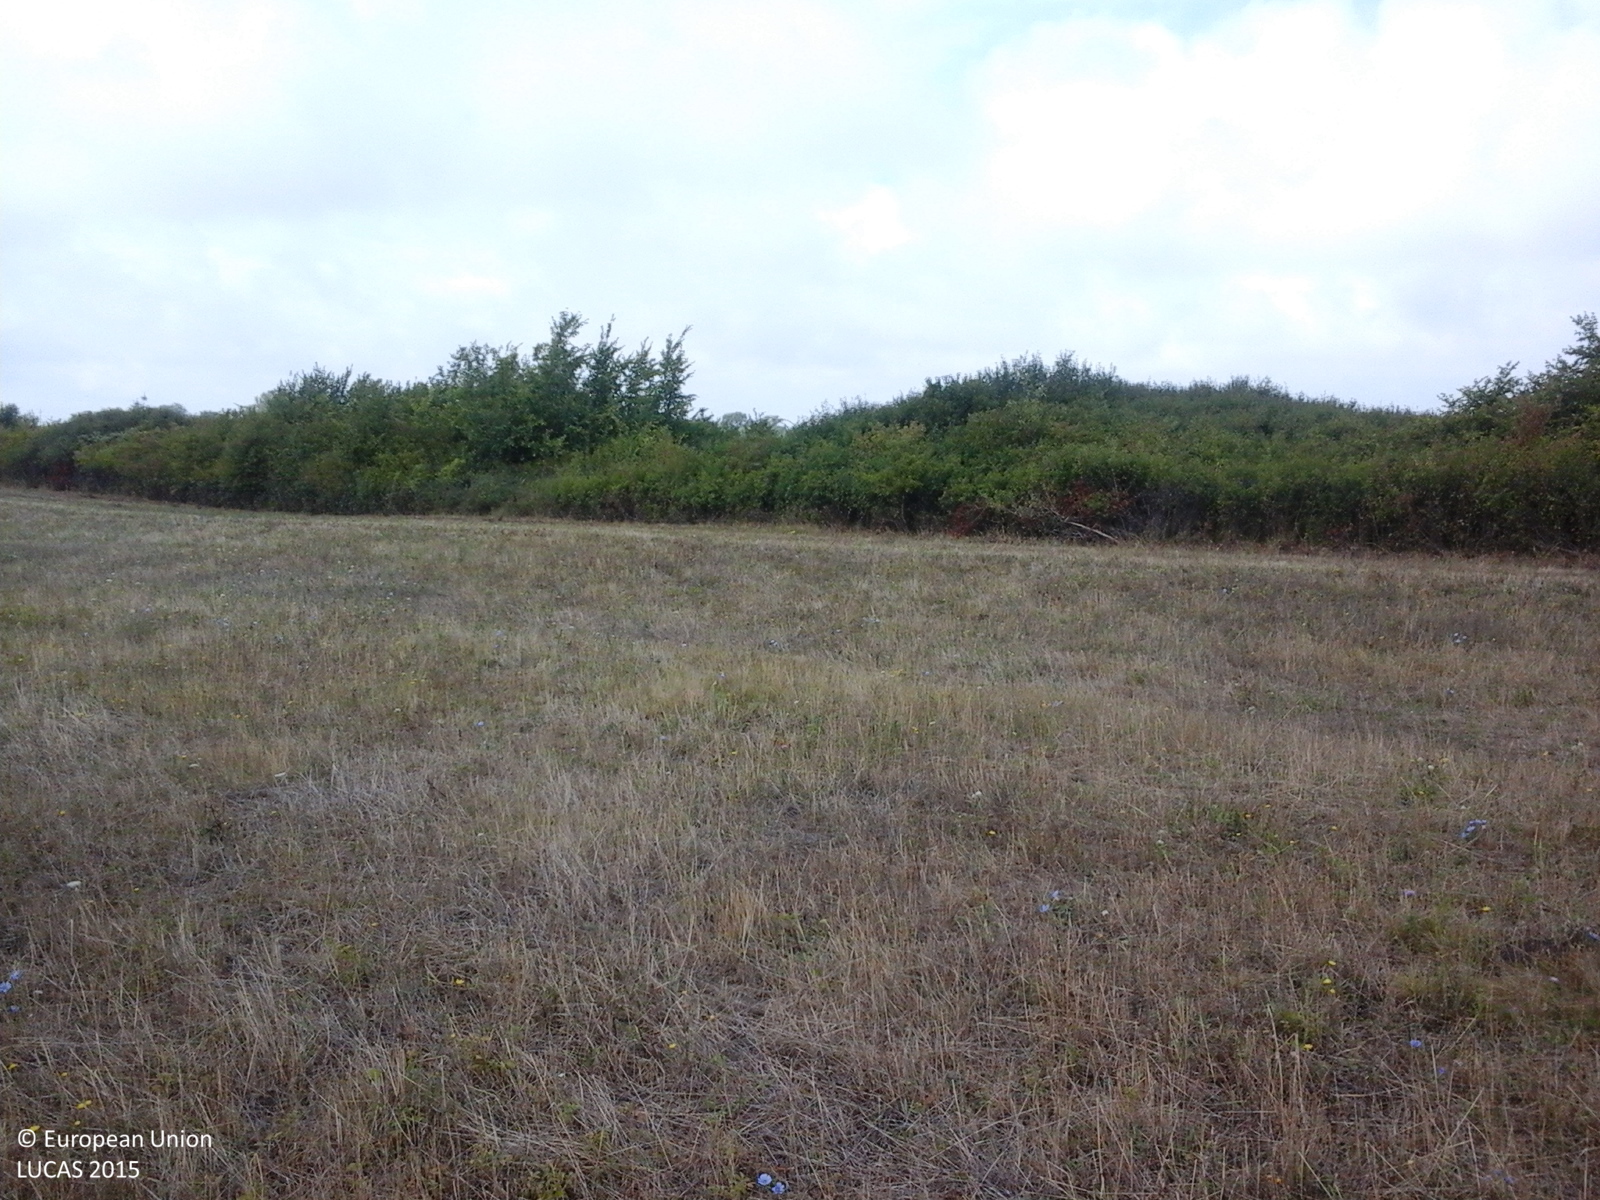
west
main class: Grassland
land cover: Grassland without tree/shrub cover
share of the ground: > 75 %
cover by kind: herbaceous plants 100 %
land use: Agriculture (excluding fallow land and kitchen gardens)
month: August
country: RO
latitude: 44.9822
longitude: 21.5063
